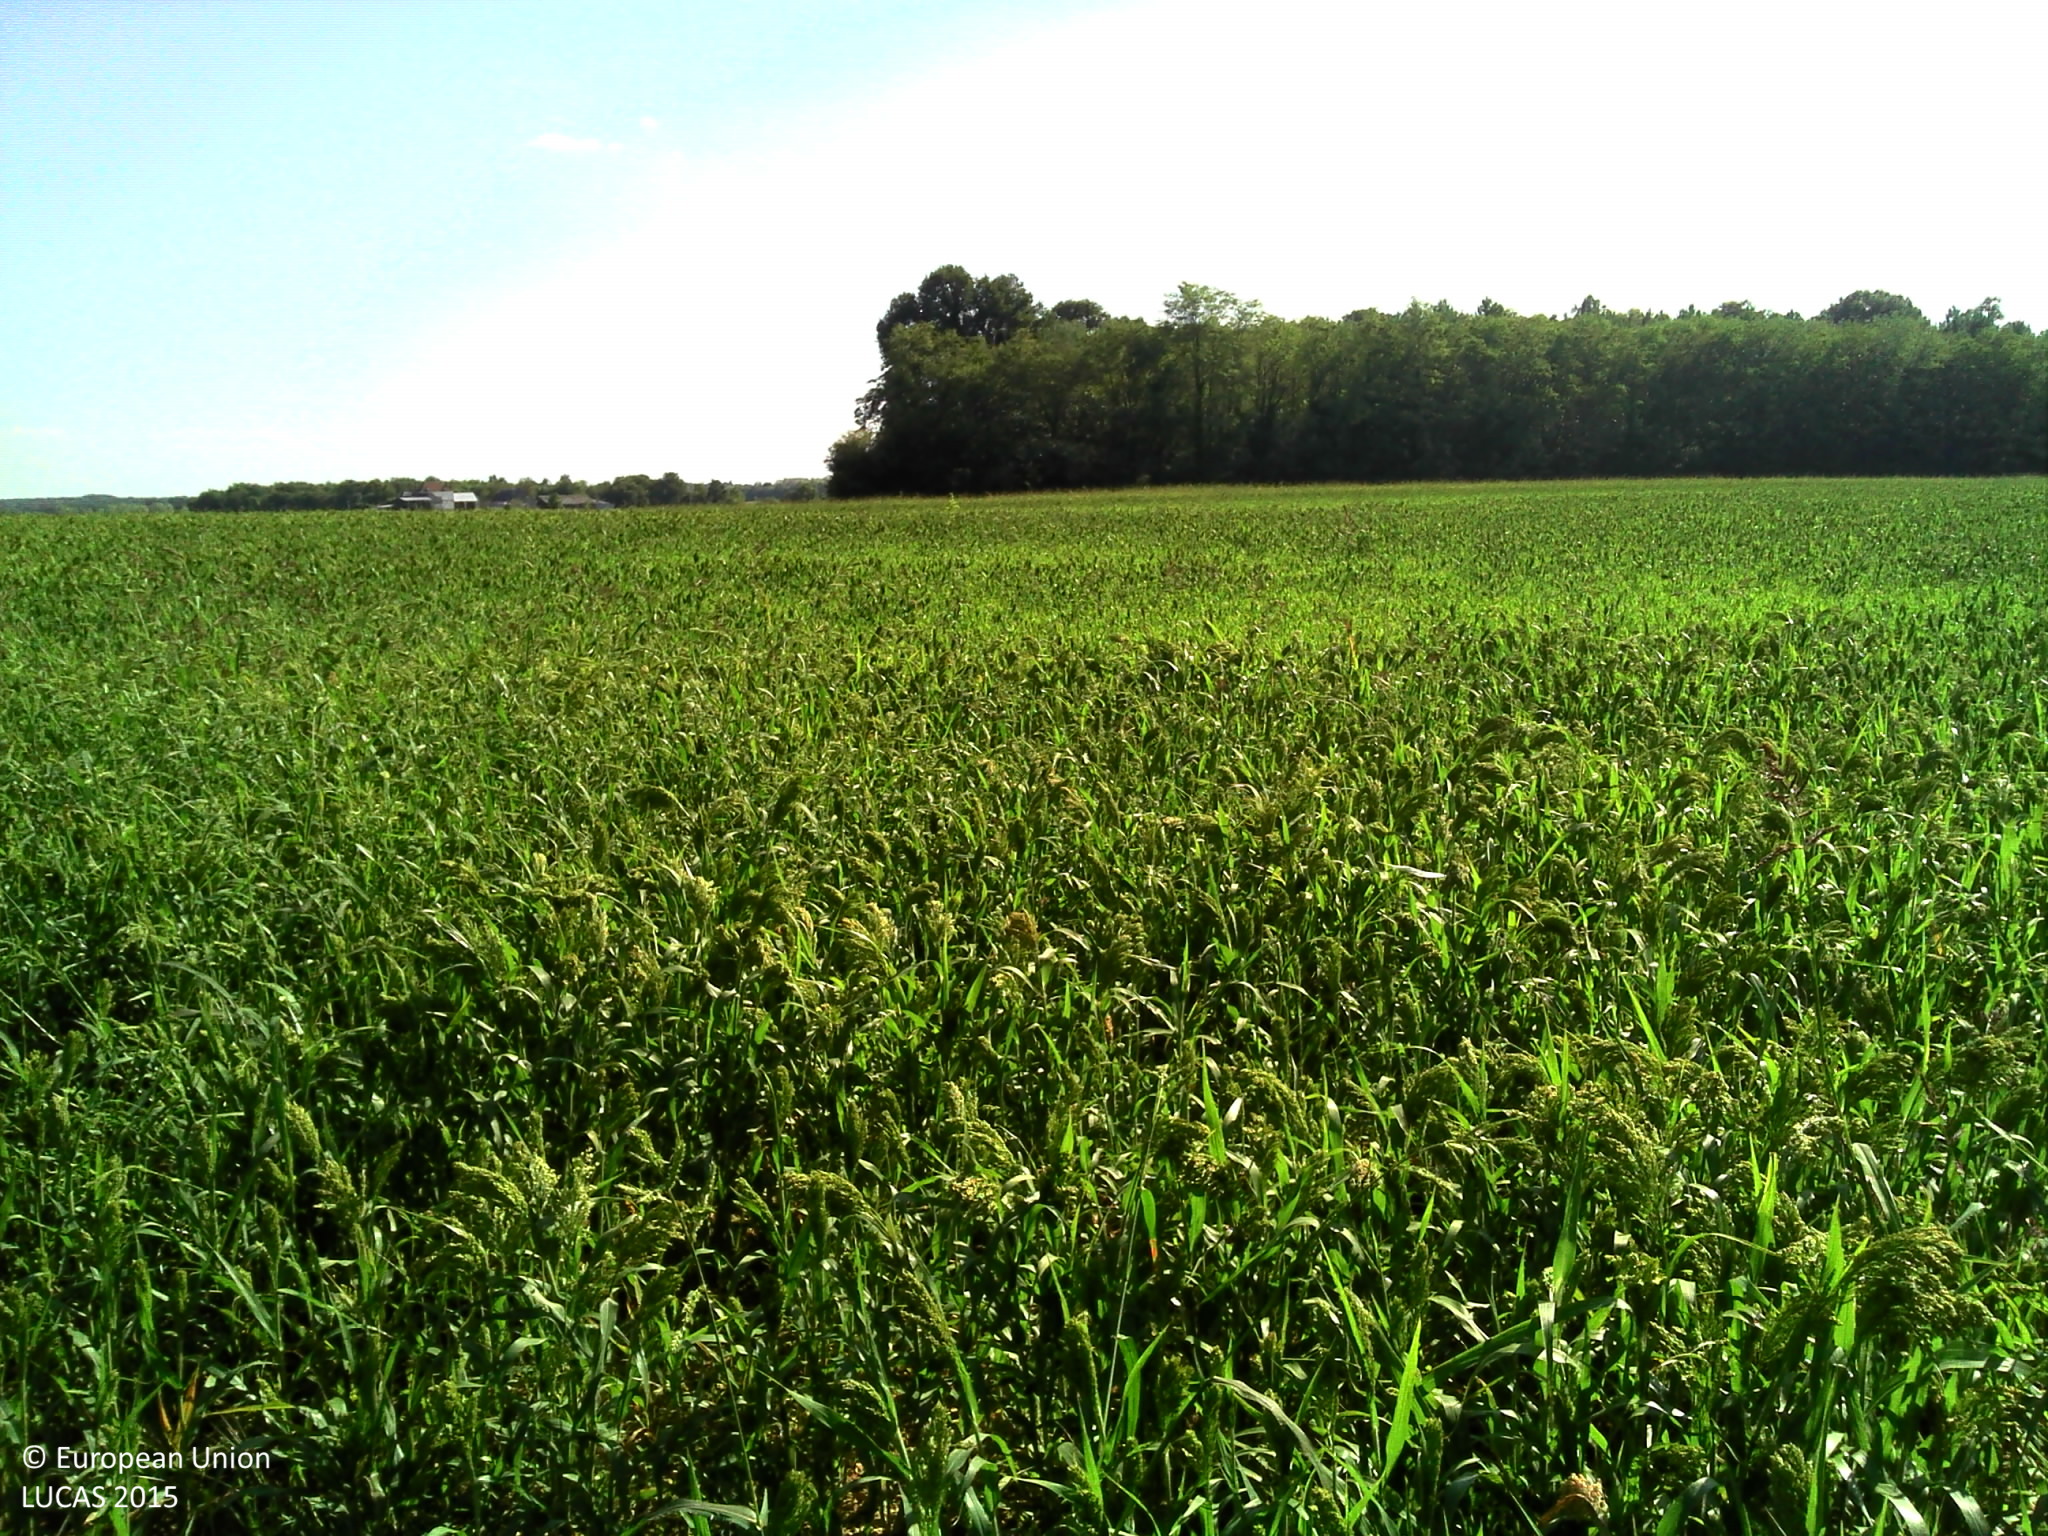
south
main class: Cropland
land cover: Other cereals
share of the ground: > 75 %
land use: Agriculture (excluding fallow land and kitchen gardens)
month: September
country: FR
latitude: 46.9746
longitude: 1.0860
